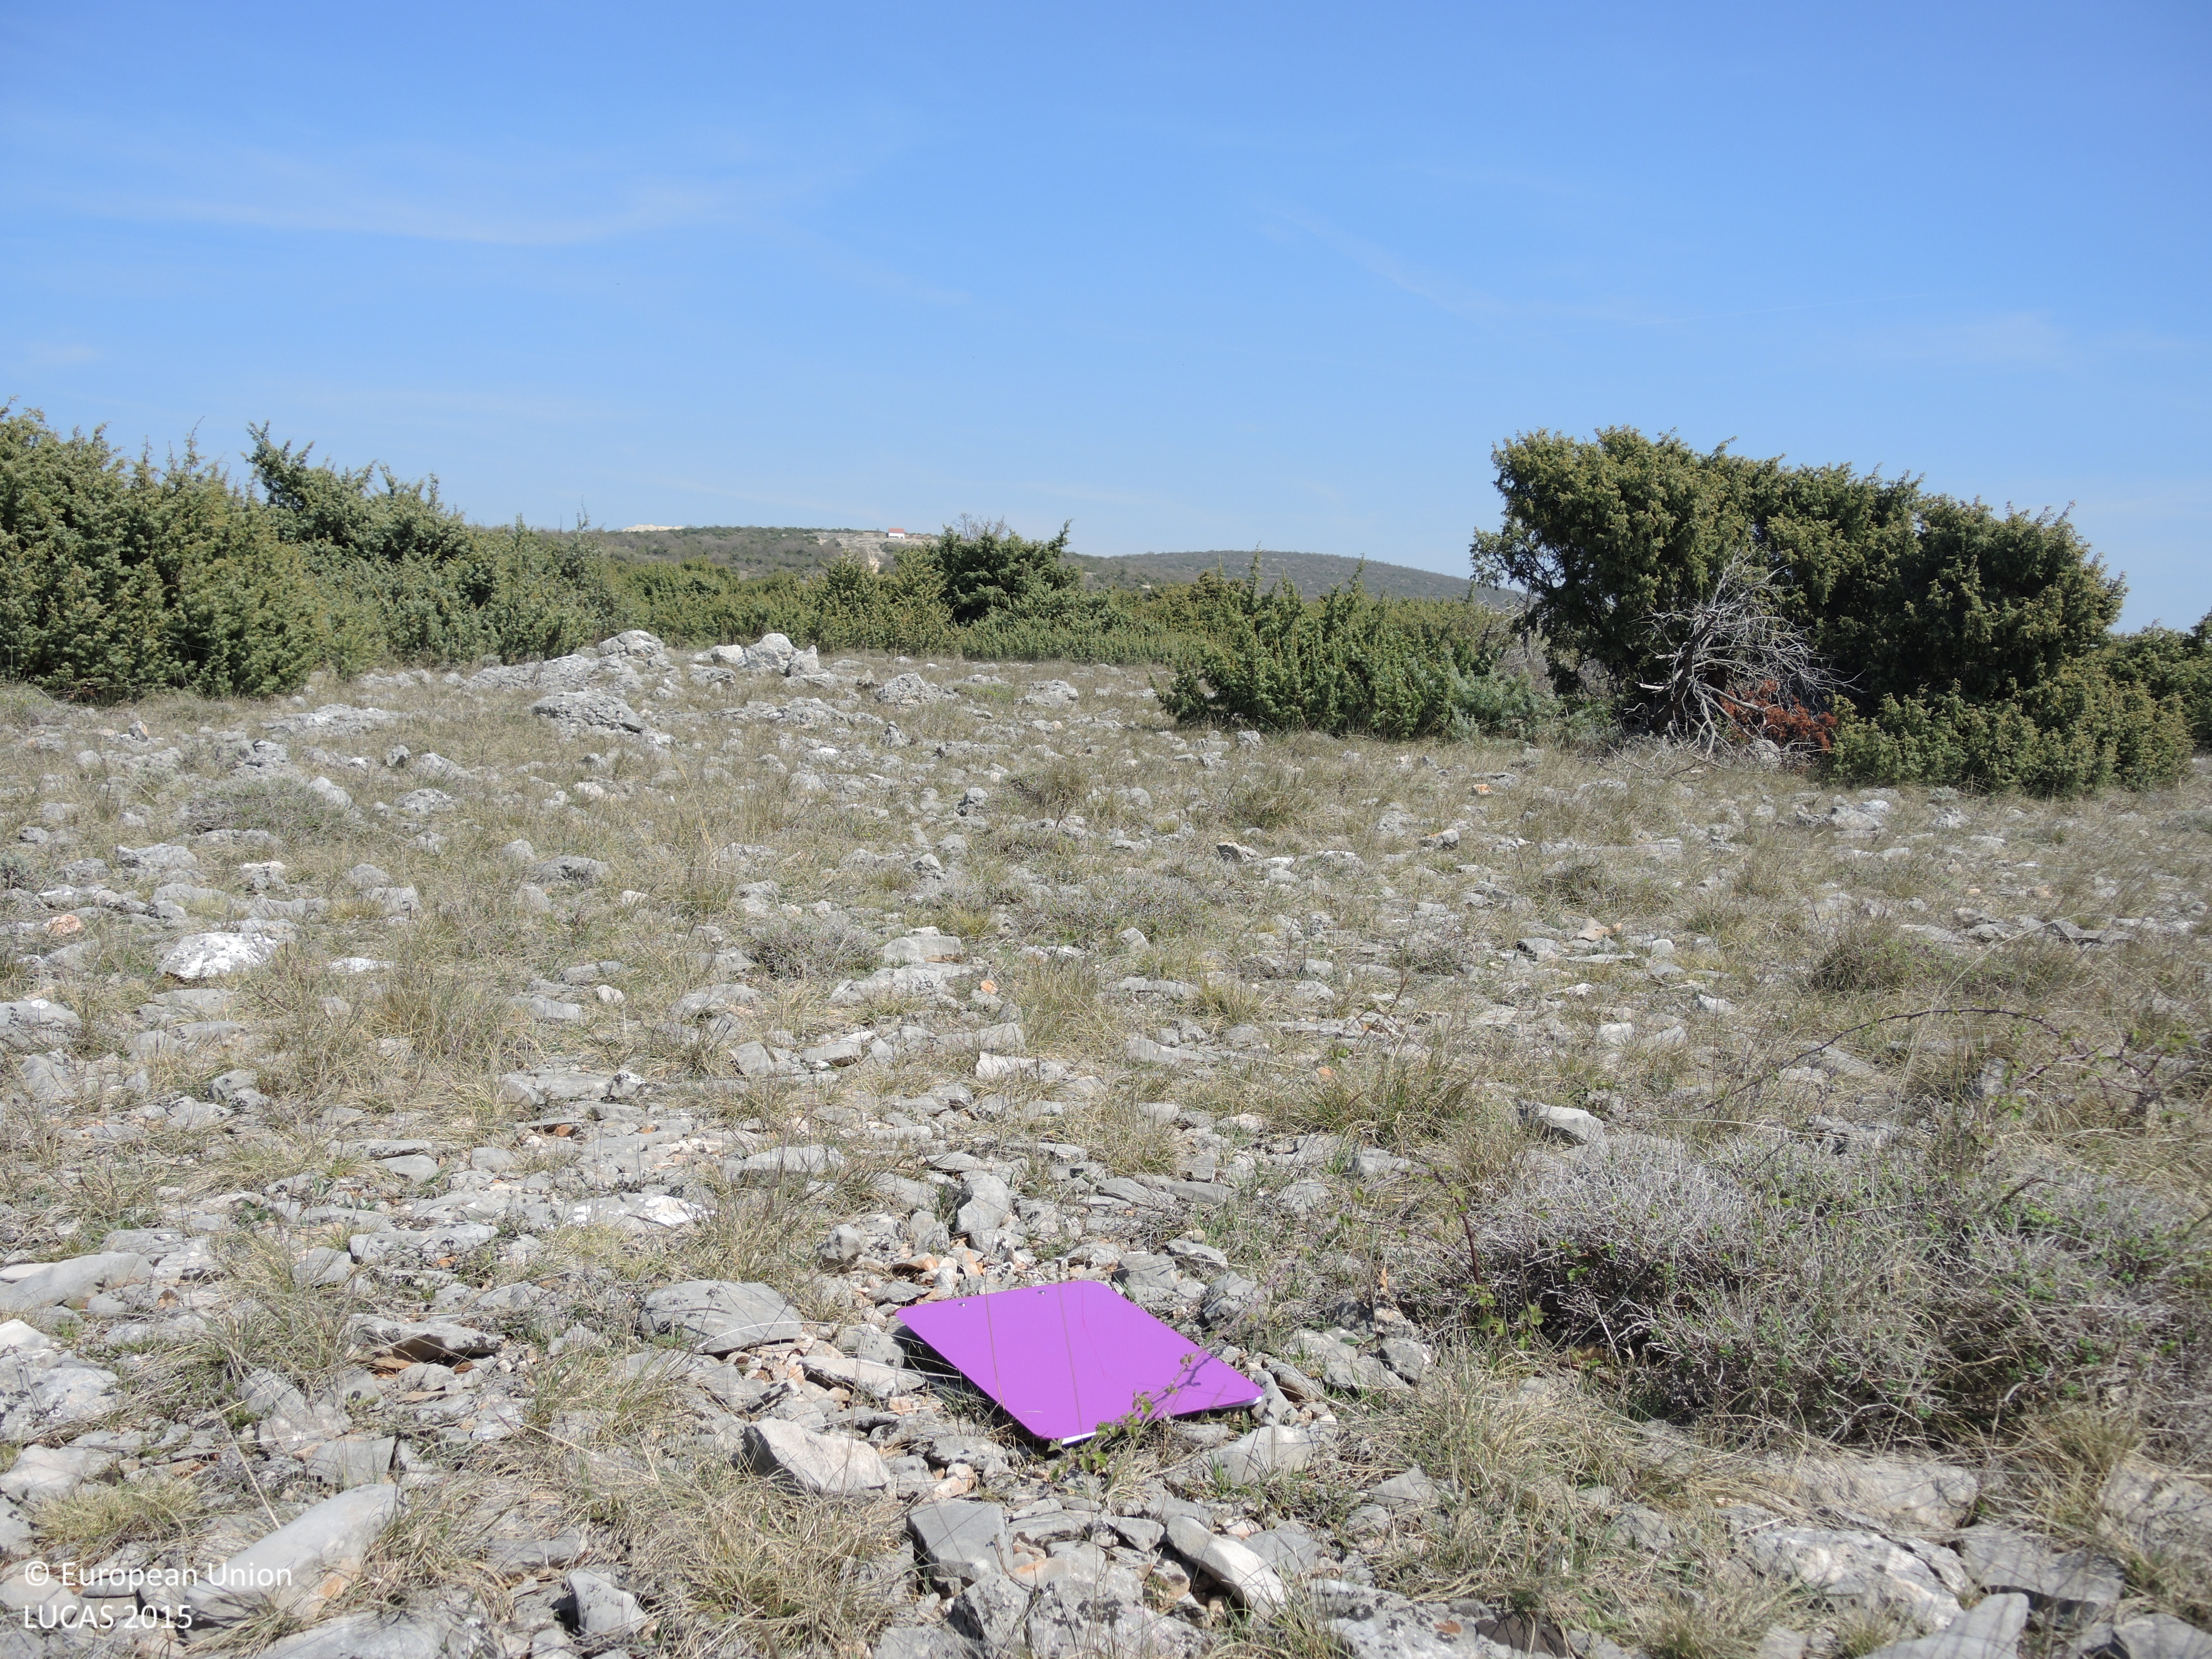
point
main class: Shrubland
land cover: Shrubland without tree cover
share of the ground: 10 - 25 %
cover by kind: unconsolidated bare surface 45 %, herbaceous plants 30 %, shrubs 15 %, consolidated bare surface 10 %
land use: Semi-natural and natural areas not in use
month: April
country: HR
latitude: 44.0135
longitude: 15.6924
